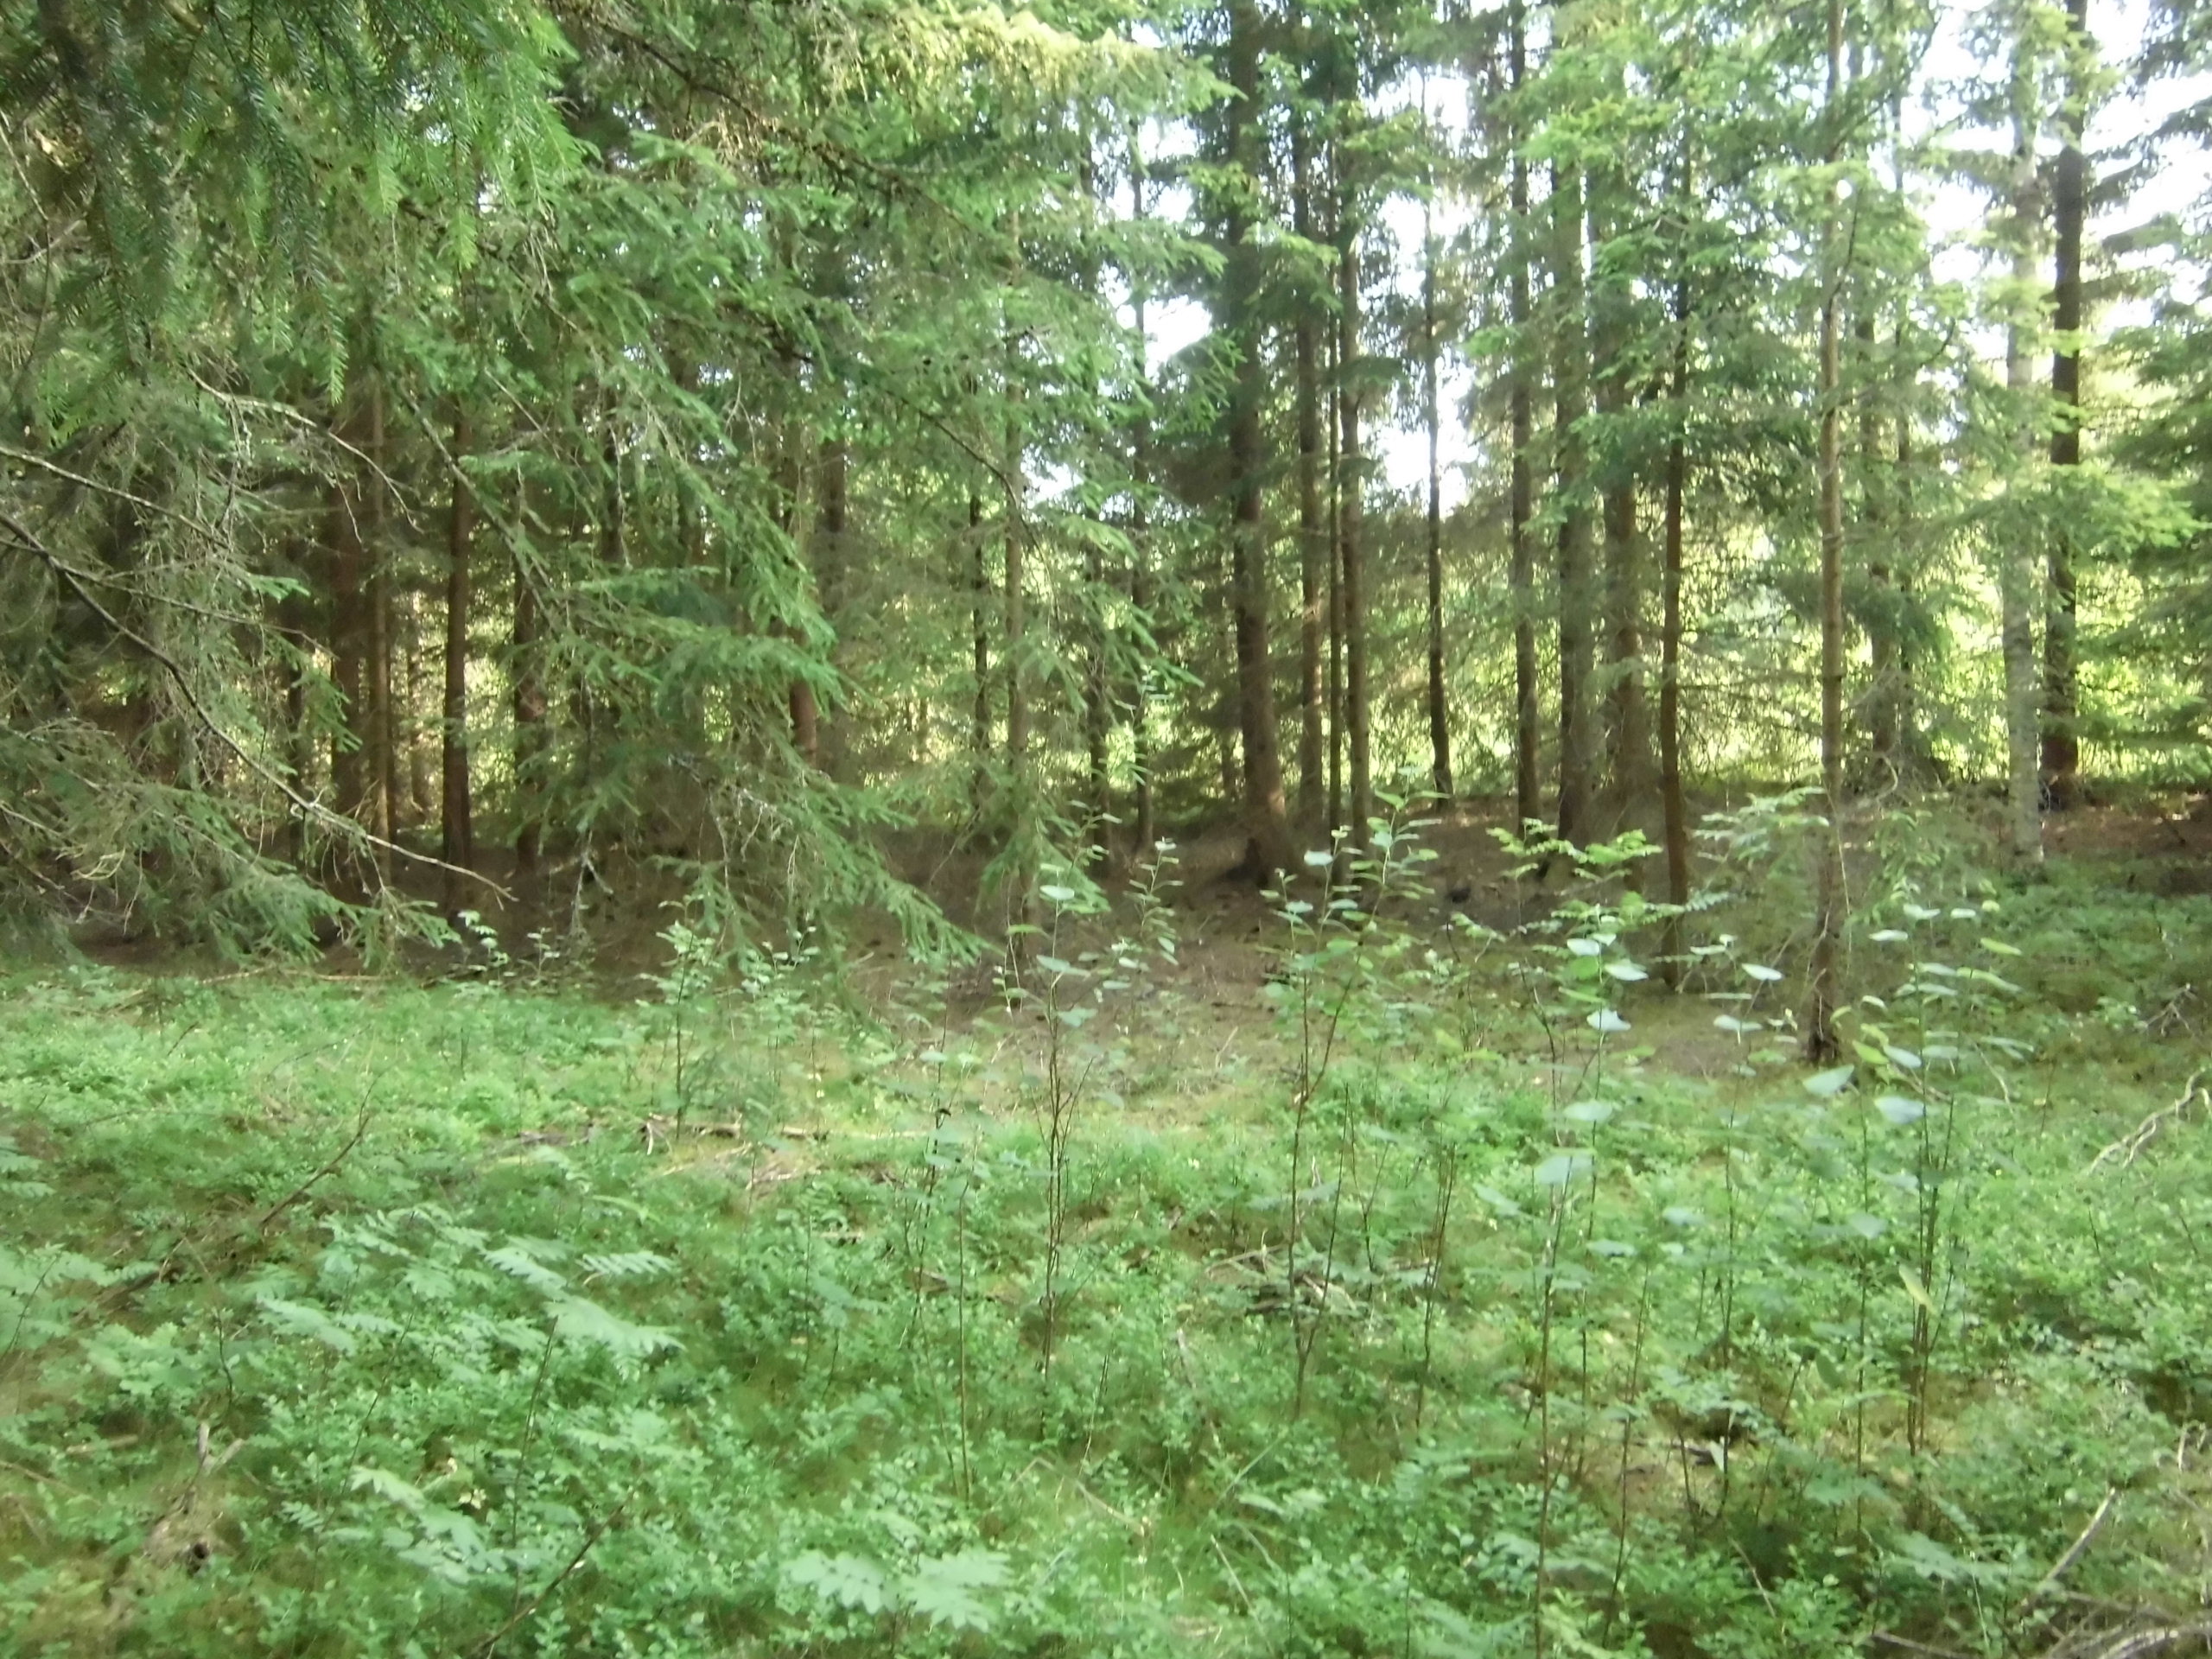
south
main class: Woodland
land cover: Spruce dominated coniferous woodland
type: boreal forest
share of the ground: > 75 %
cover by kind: coniferous forest trees 75 %, lichens and mosses 10 %, broadleaved forest trees 5 %, shrubs 5 %, unconsolidated bare surface 5 %
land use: Forestry
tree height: > 5 m
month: July
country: SE
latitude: 57.3614
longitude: 14.7340
